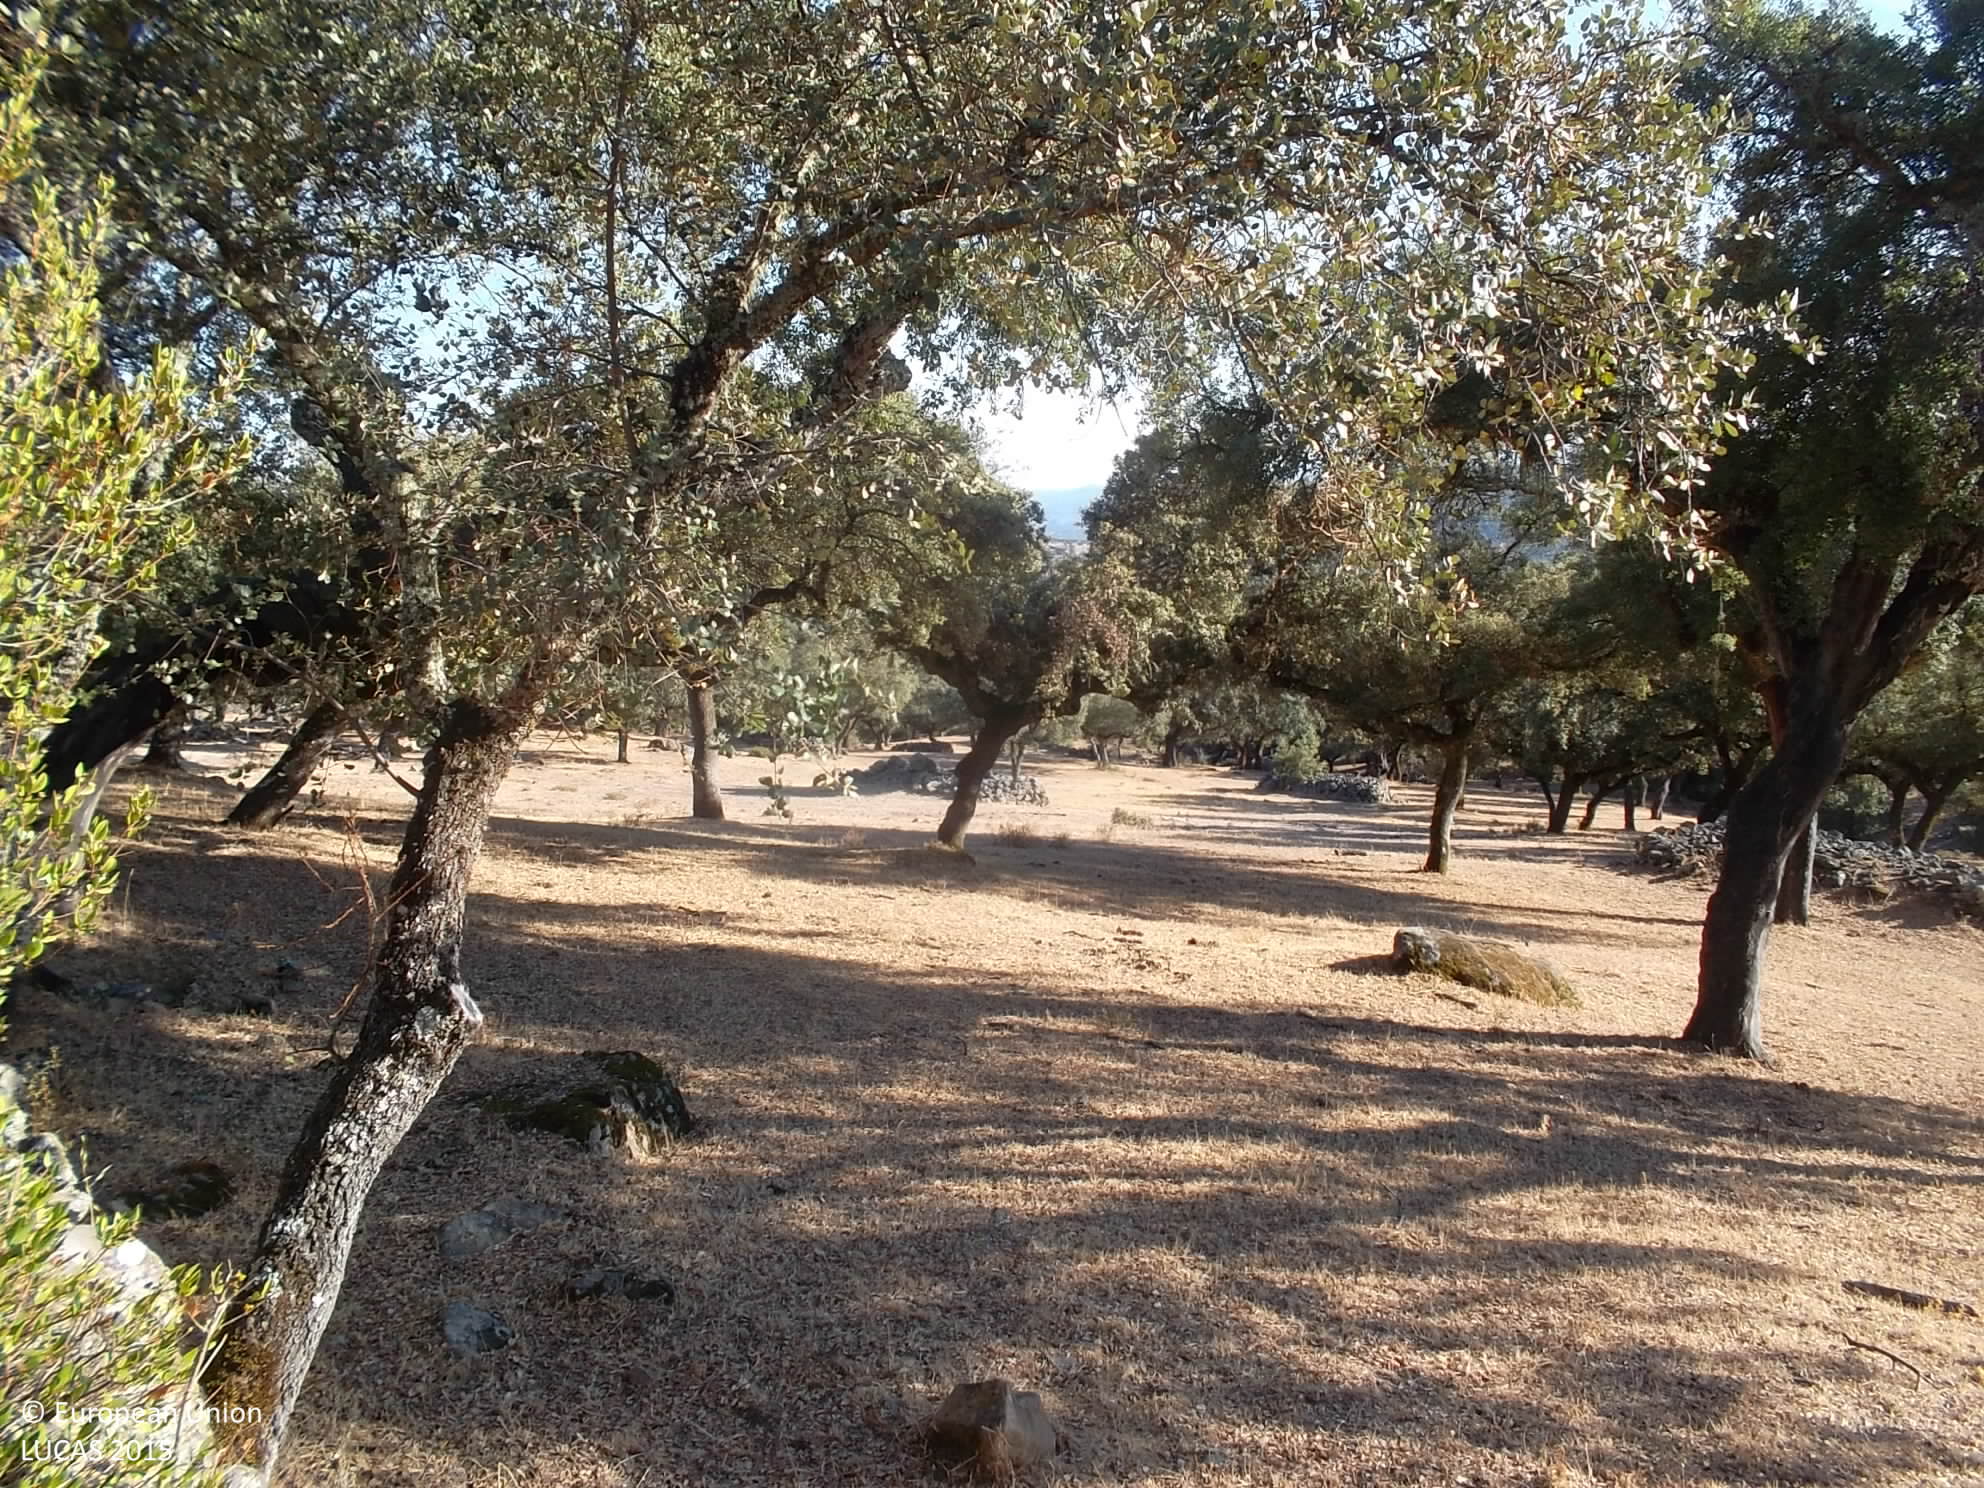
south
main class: Woodland
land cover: Broadleaved woodland
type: broadleaved evergreen forest
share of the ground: 50 - 75 %
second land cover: Grassland without tree/shrub cover
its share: > 75 %
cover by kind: broadleaved forest trees 50 %, herbaceous plants 50 %
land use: Forestry
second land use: Agriculture (excluding fallow land and kitchen gardens)
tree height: > 5 m
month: August
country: ES
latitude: 38.4271
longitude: -6.6531
